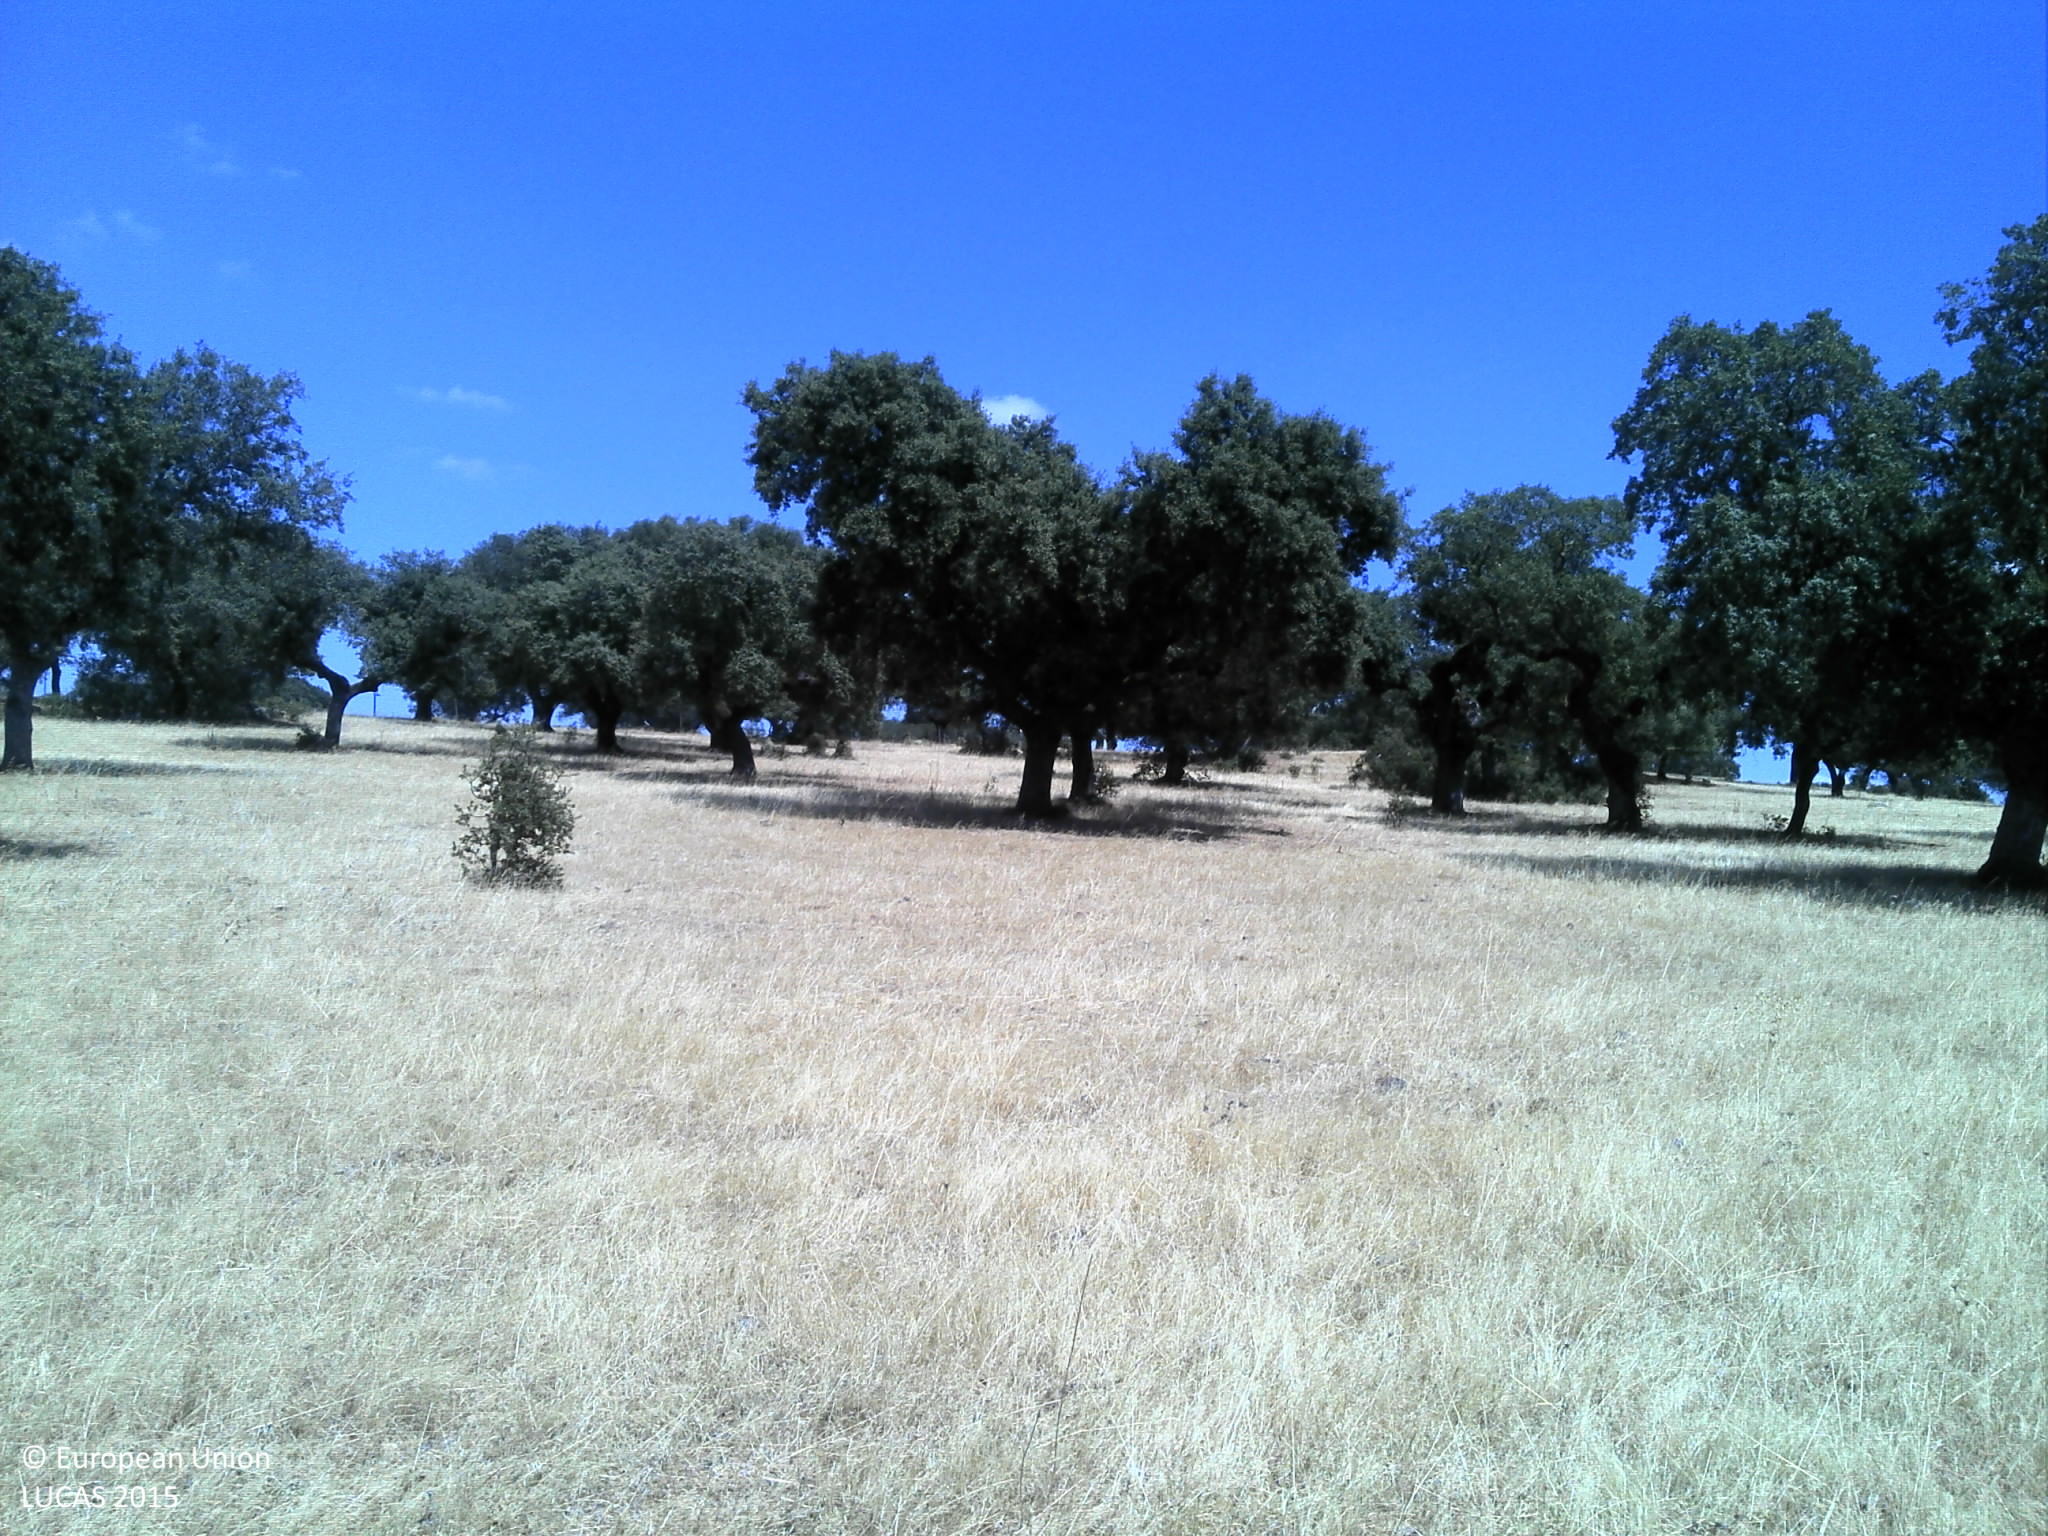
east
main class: Woodland
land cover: Broadleaved woodland
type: broadleaved evergreen forest
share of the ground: 25 - 50 %
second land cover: Grassland without tree/shrub cover
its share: 50 - 75 %
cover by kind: herbaceous plants 65 %, broadleaved forest trees 25 %, unconsolidated bare surface 10 %
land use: Forestry
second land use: Agriculture (excluding fallow land and kitchen gardens)
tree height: > 5 m
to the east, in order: Broadleaved woodland; Grassland without tree/shrub cover; Broadleaved woodland
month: July
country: PT
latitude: 38.8204
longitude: -7.3418
